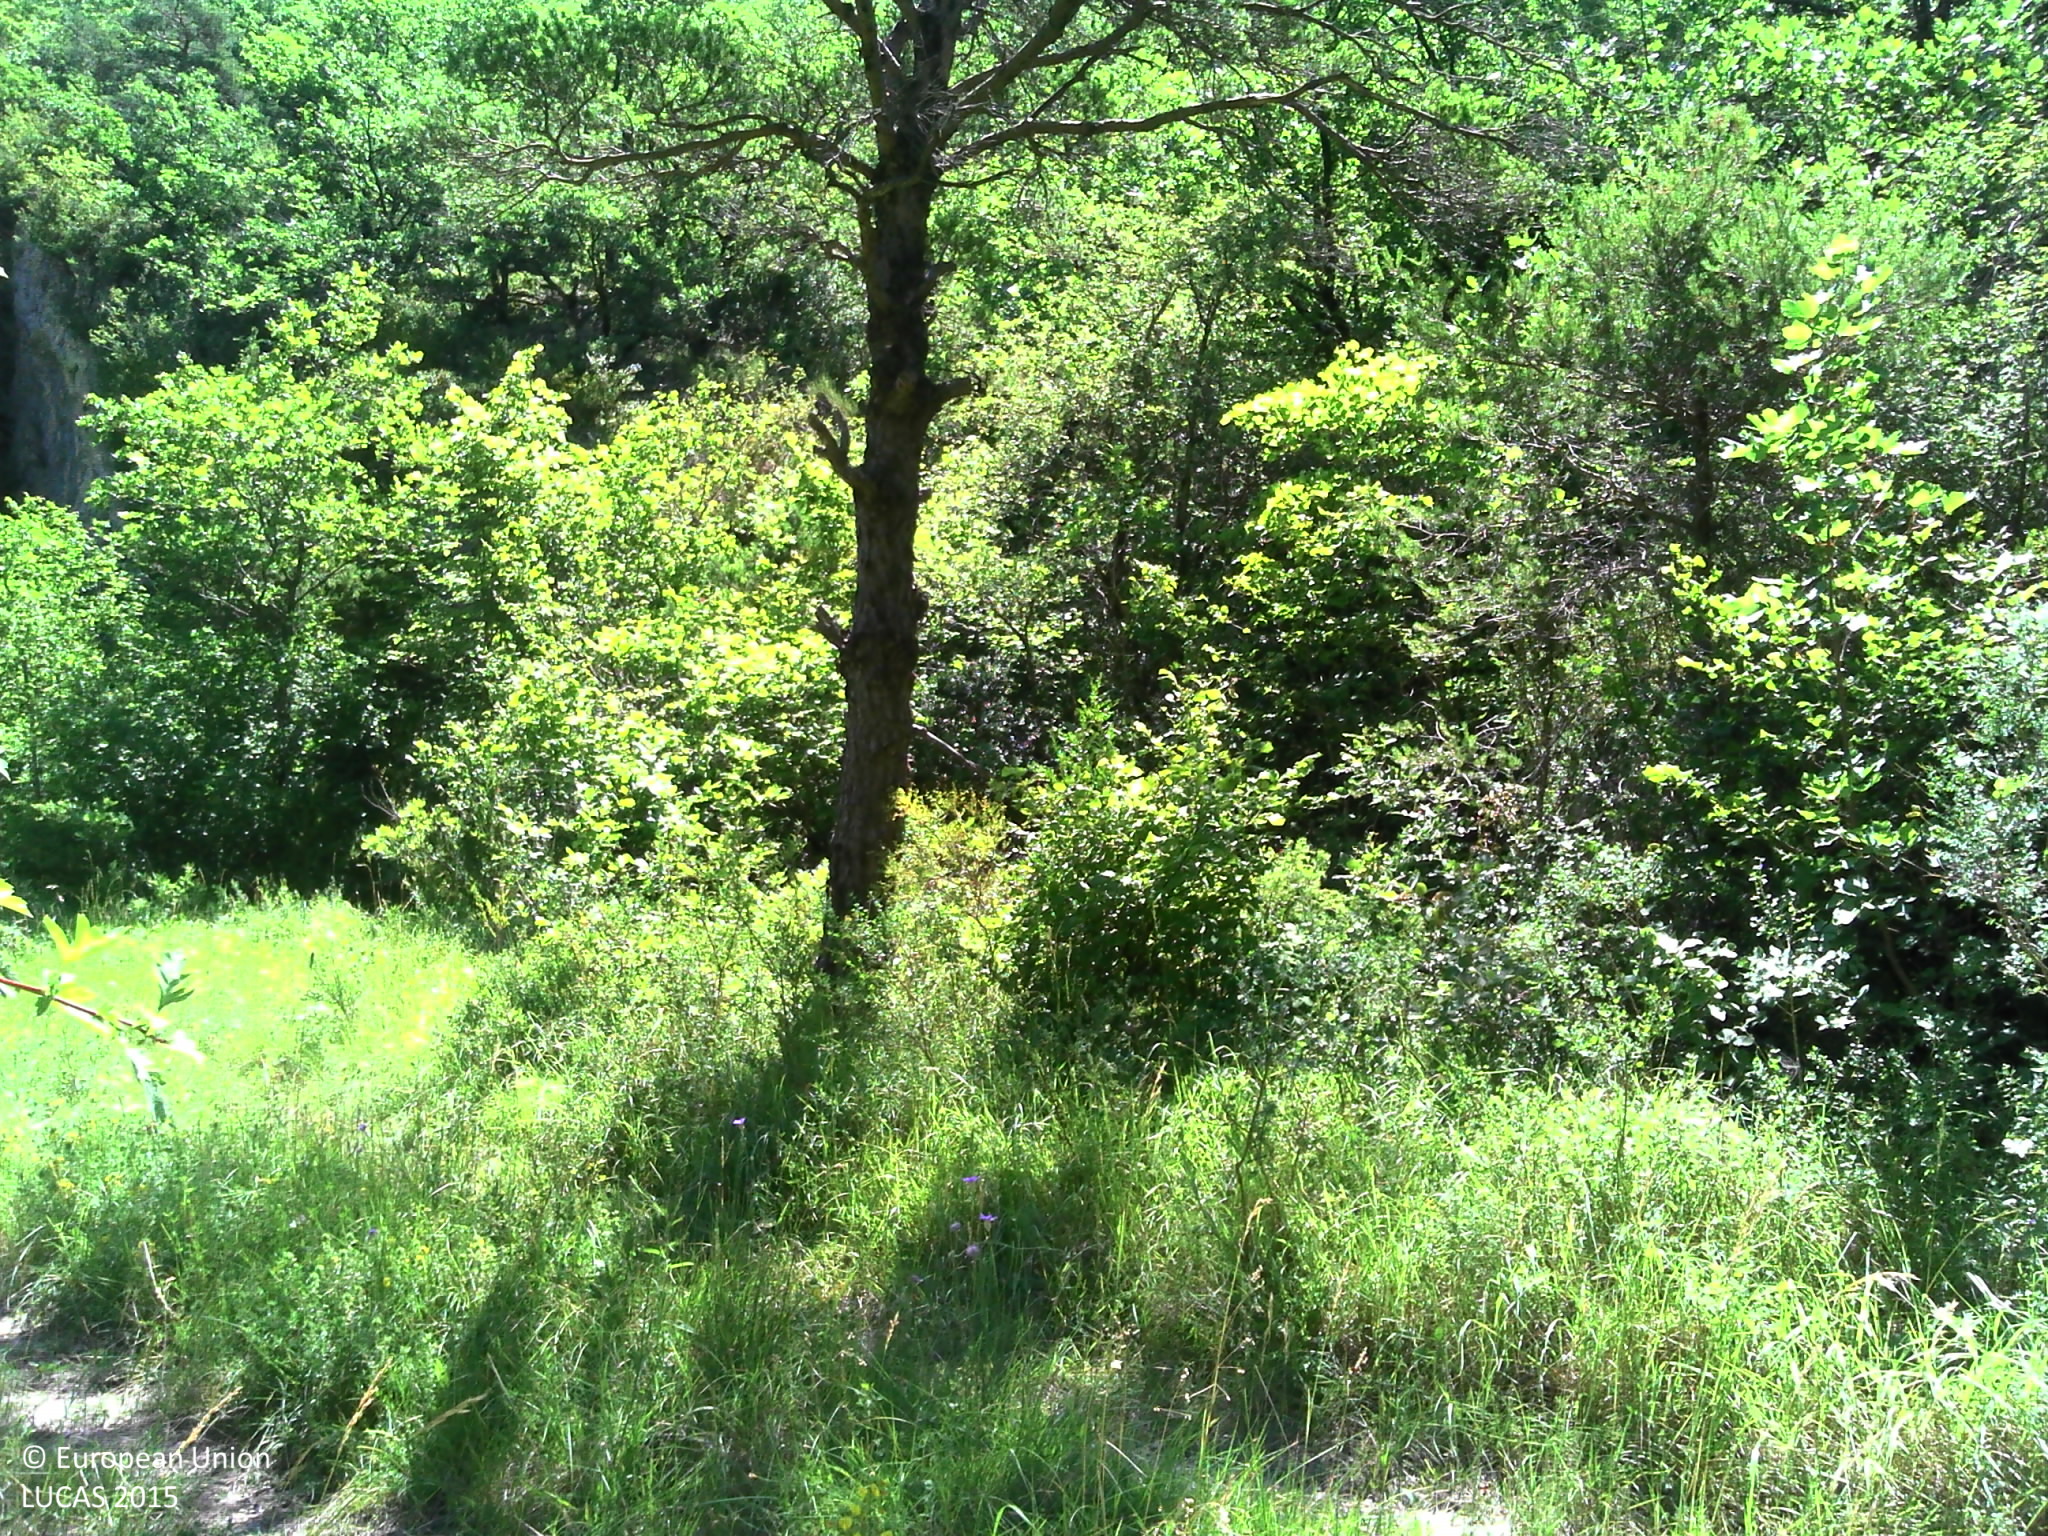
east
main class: Woodland
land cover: Broadleaved woodland
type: mesophytic deciduous forest
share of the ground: > 75 %
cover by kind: broadleaved forest trees 100 %
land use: Forestry
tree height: > 5 m
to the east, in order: Broadleaved woodland; Tracks; Broadleaved woodland; Rocks and stones; Broadleaved woodland
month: June
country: FR
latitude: 44.5076
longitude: 5.1391
